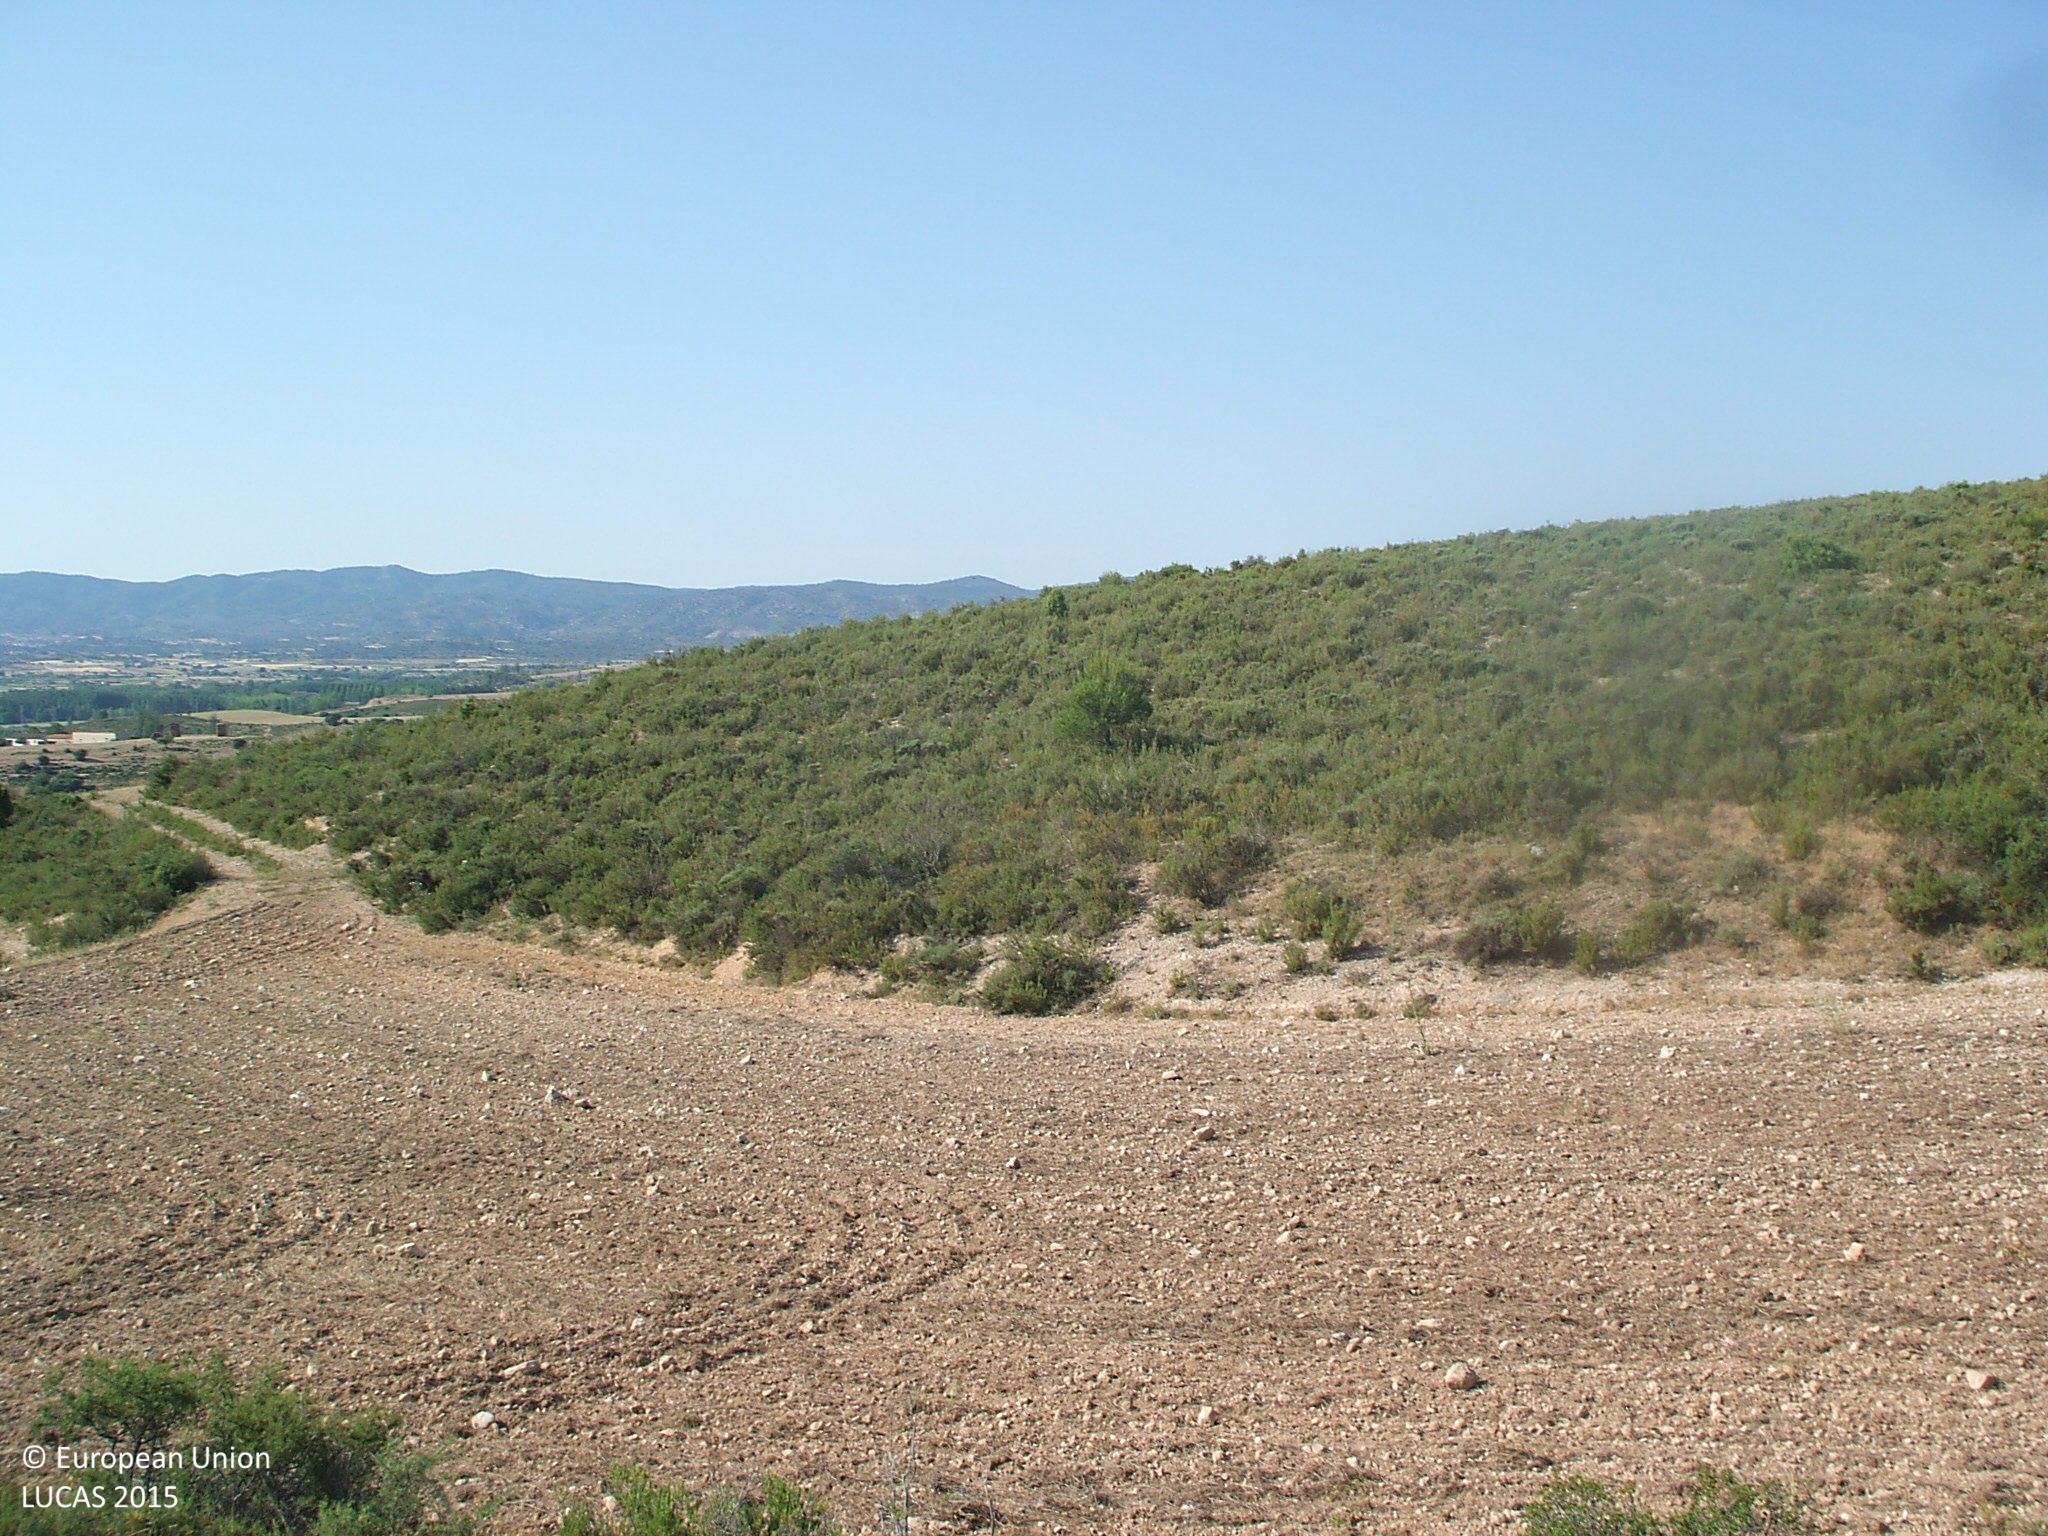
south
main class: Shrubland
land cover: Shrubland without tree cover
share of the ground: 50 - 75 %
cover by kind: shrubs 70 %, consolidated bare surface 30 %
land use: Semi-natural and natural areas not in use
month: June
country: ES
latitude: 40.8792
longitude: -0.2277
